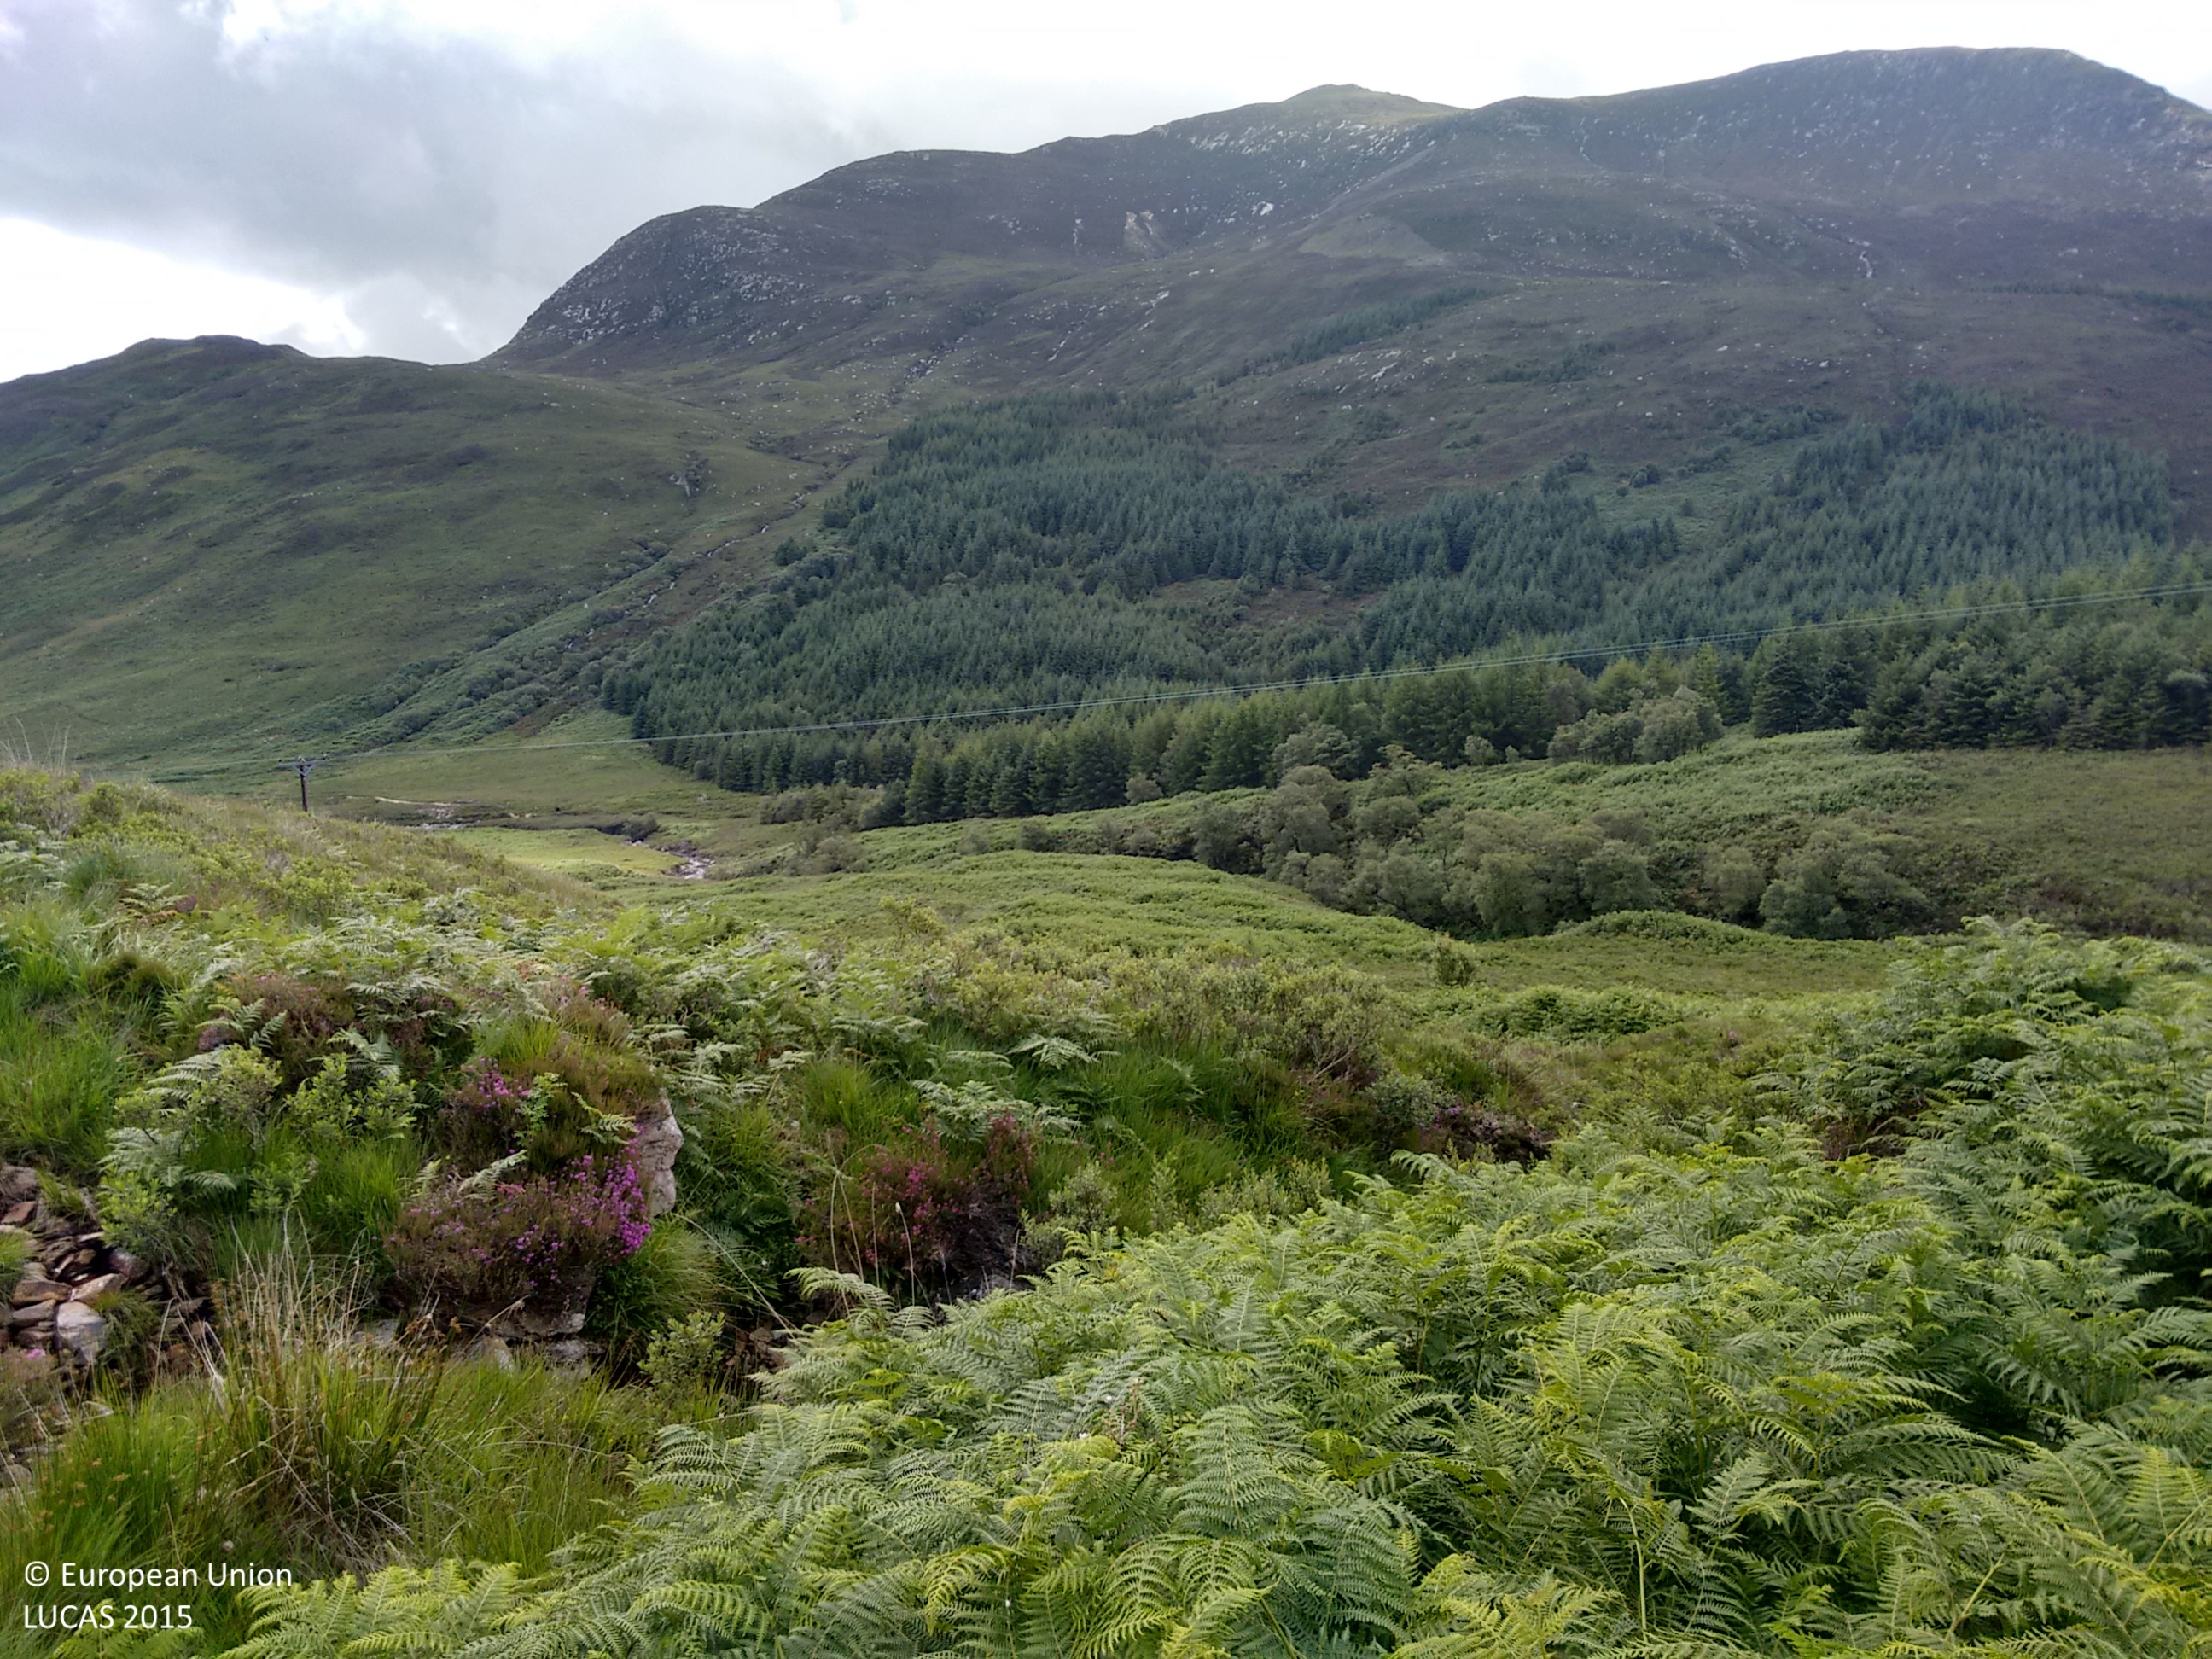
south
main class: Shrubland
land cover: Shrubland without tree cover
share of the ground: > 75 %
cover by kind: shrubs 80 %, herbaceous plants 20 %
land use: Semi-natural and natural areas not in use
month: July
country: GB
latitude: 55.6769
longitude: -5.2074
